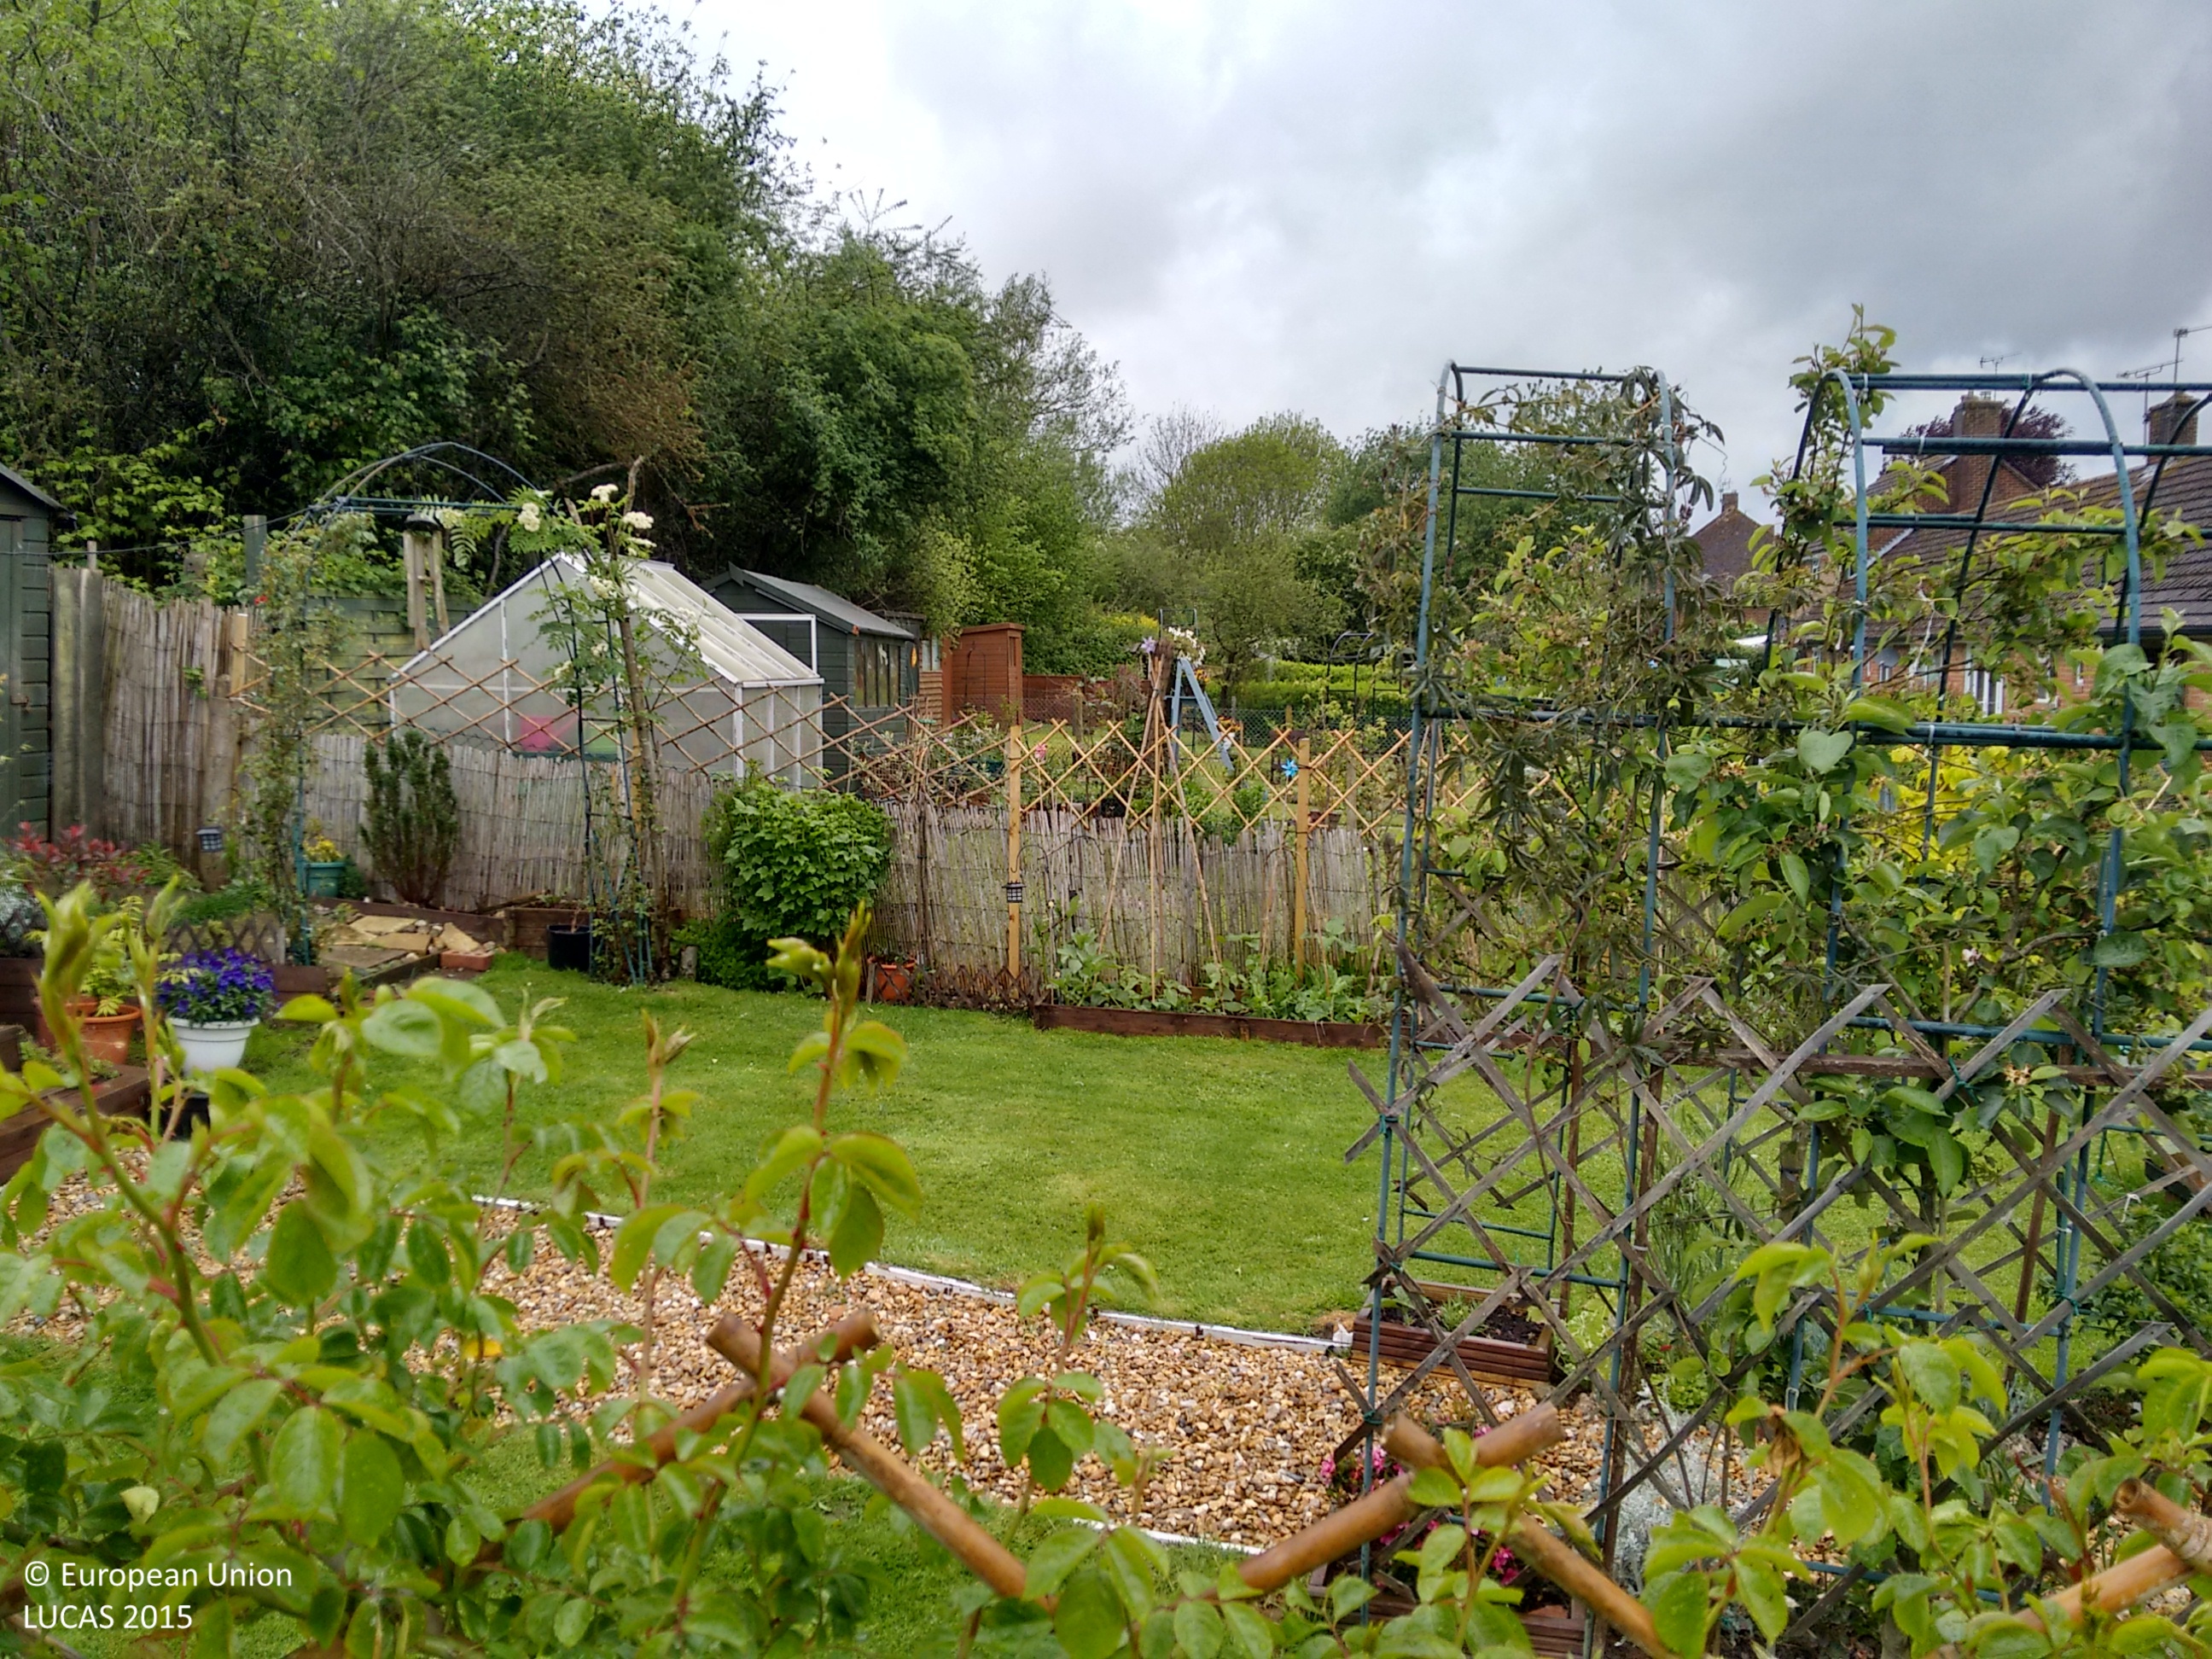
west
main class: Grassland
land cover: Grassland without tree/shrub cover
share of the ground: > 75 %
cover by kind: herbaceous plants 85 %, consolidated bare surface 10 %, shrubs 5 %
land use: Residential
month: May
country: GB
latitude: 50.9987
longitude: -0.9444
